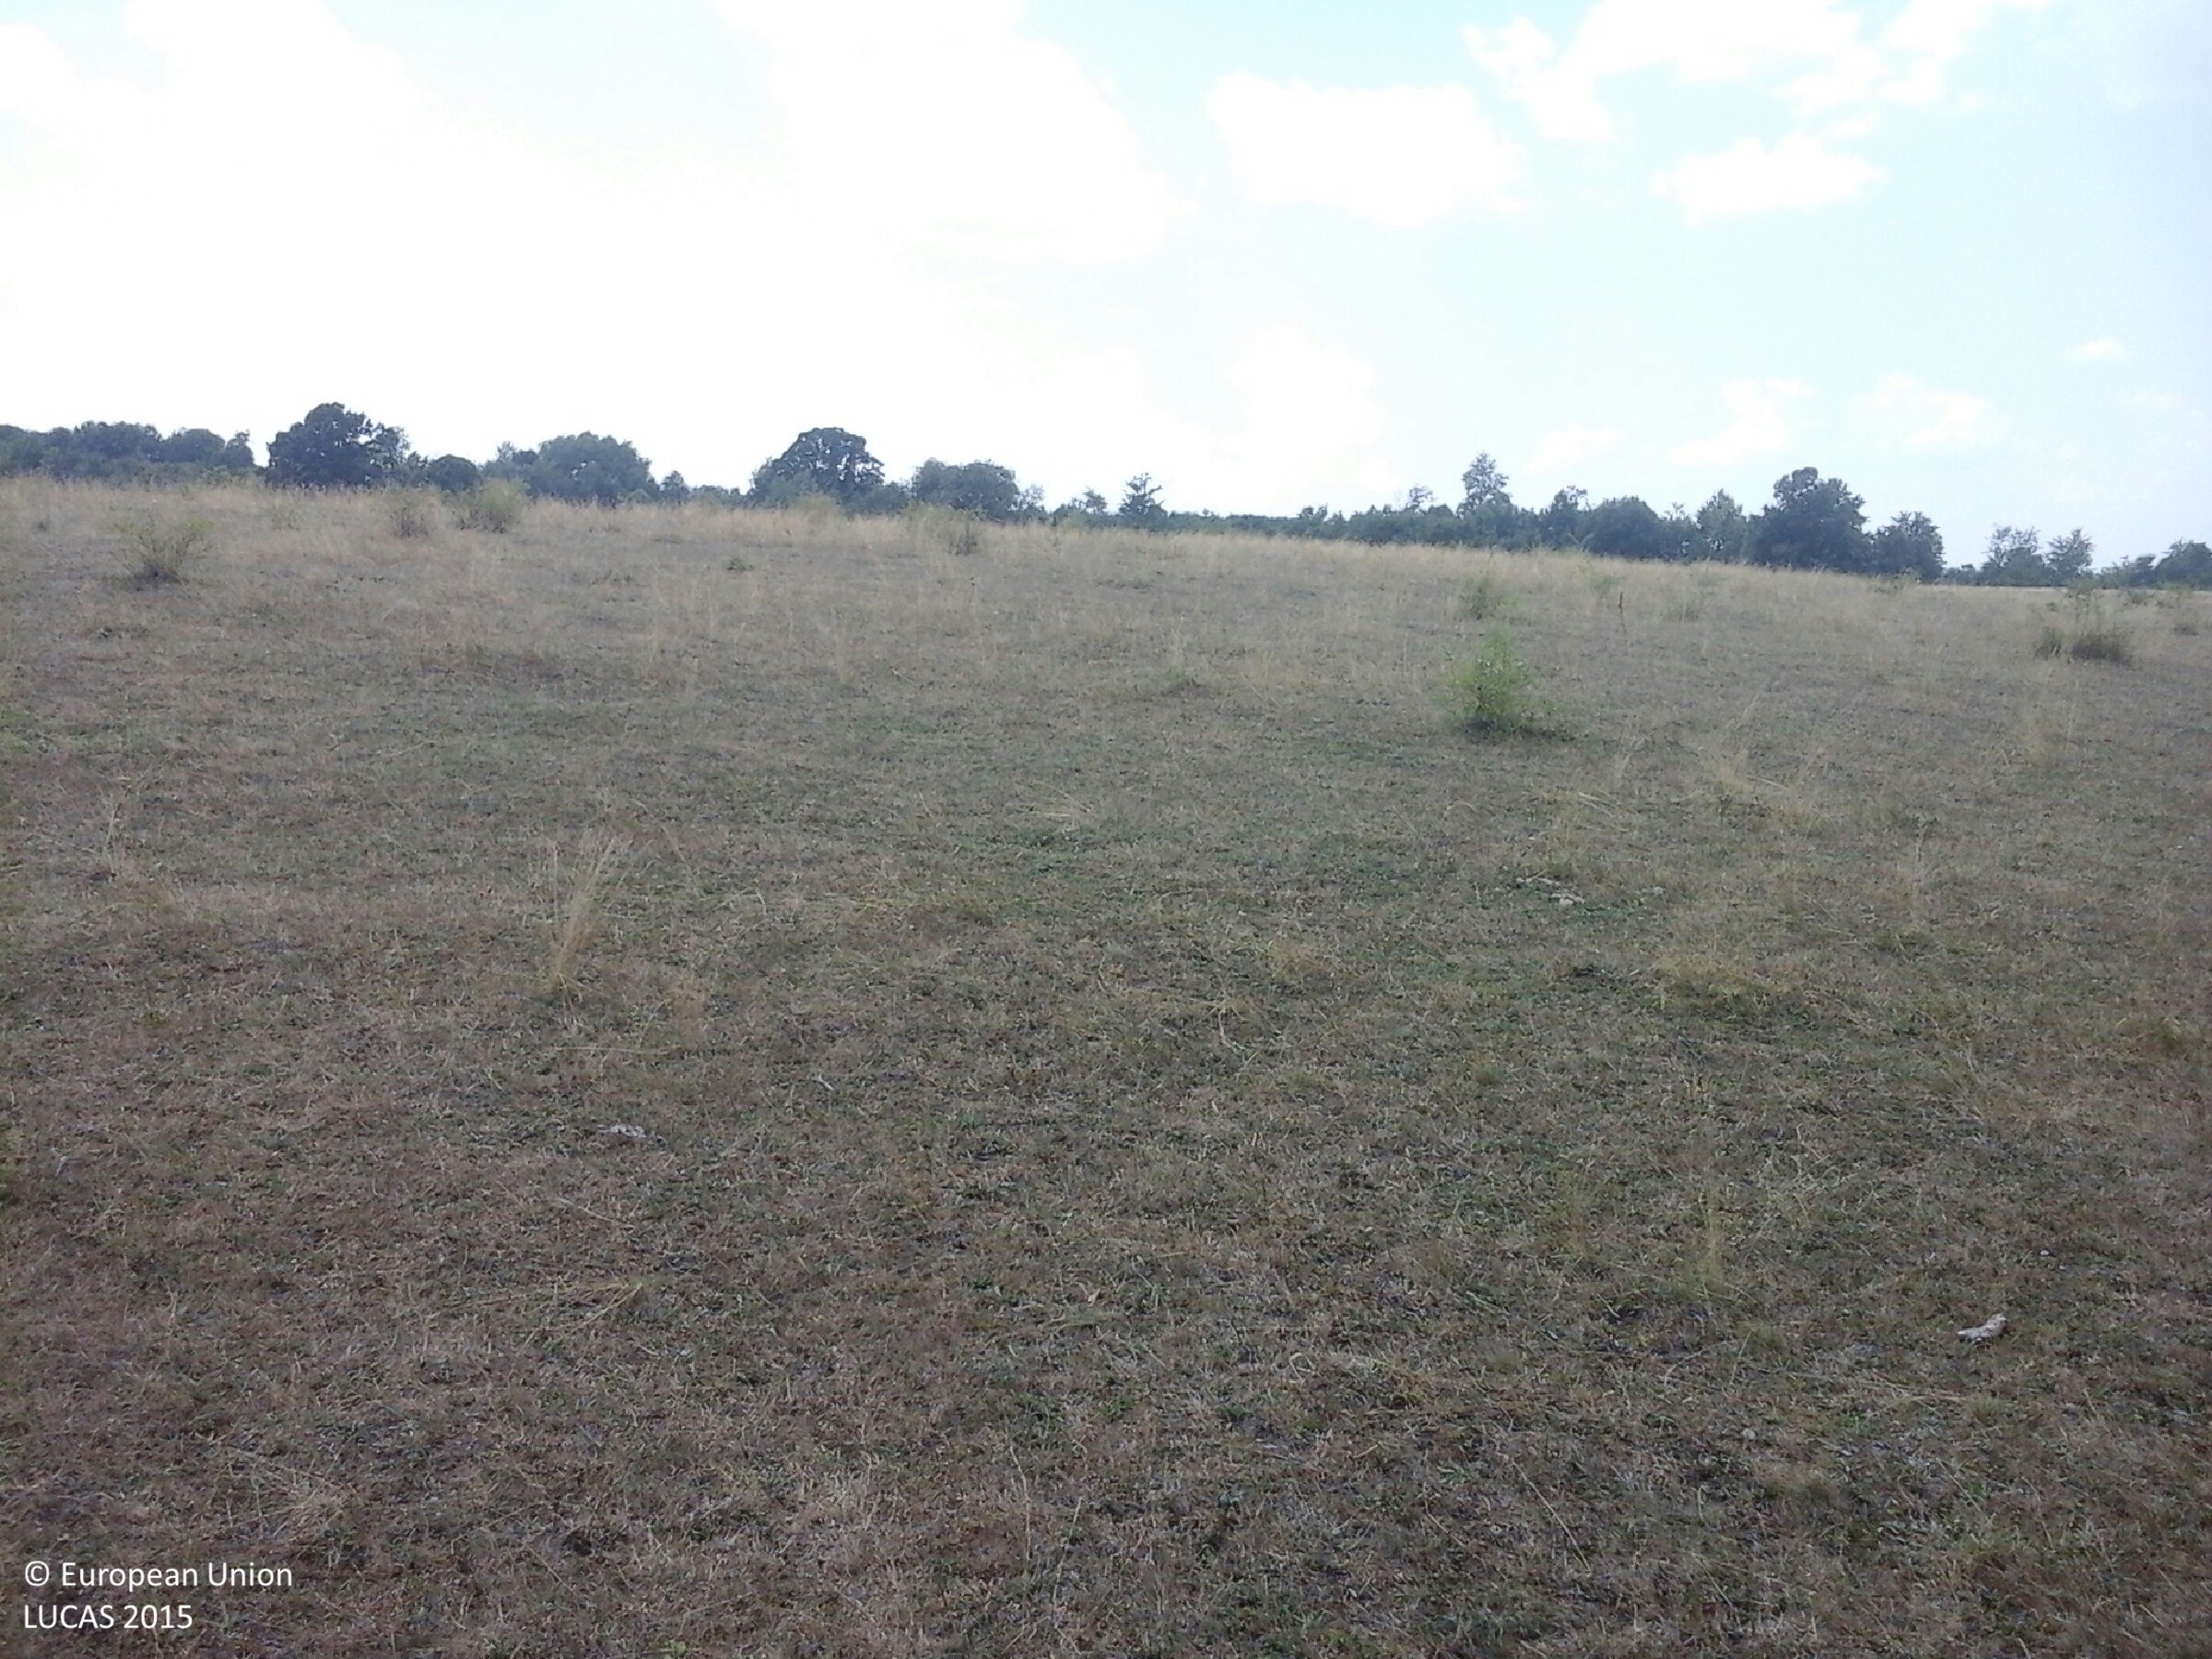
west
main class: Grassland
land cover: Grassland with sparse tree/shrub cover
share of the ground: > 75 %
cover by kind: herbaceous plants 95 %, broadleaved forest trees 5 %
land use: Agriculture (excluding fallow land and kitchen gardens)
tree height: > 5 m
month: July
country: HU
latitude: 48.1427
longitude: 20.6391
